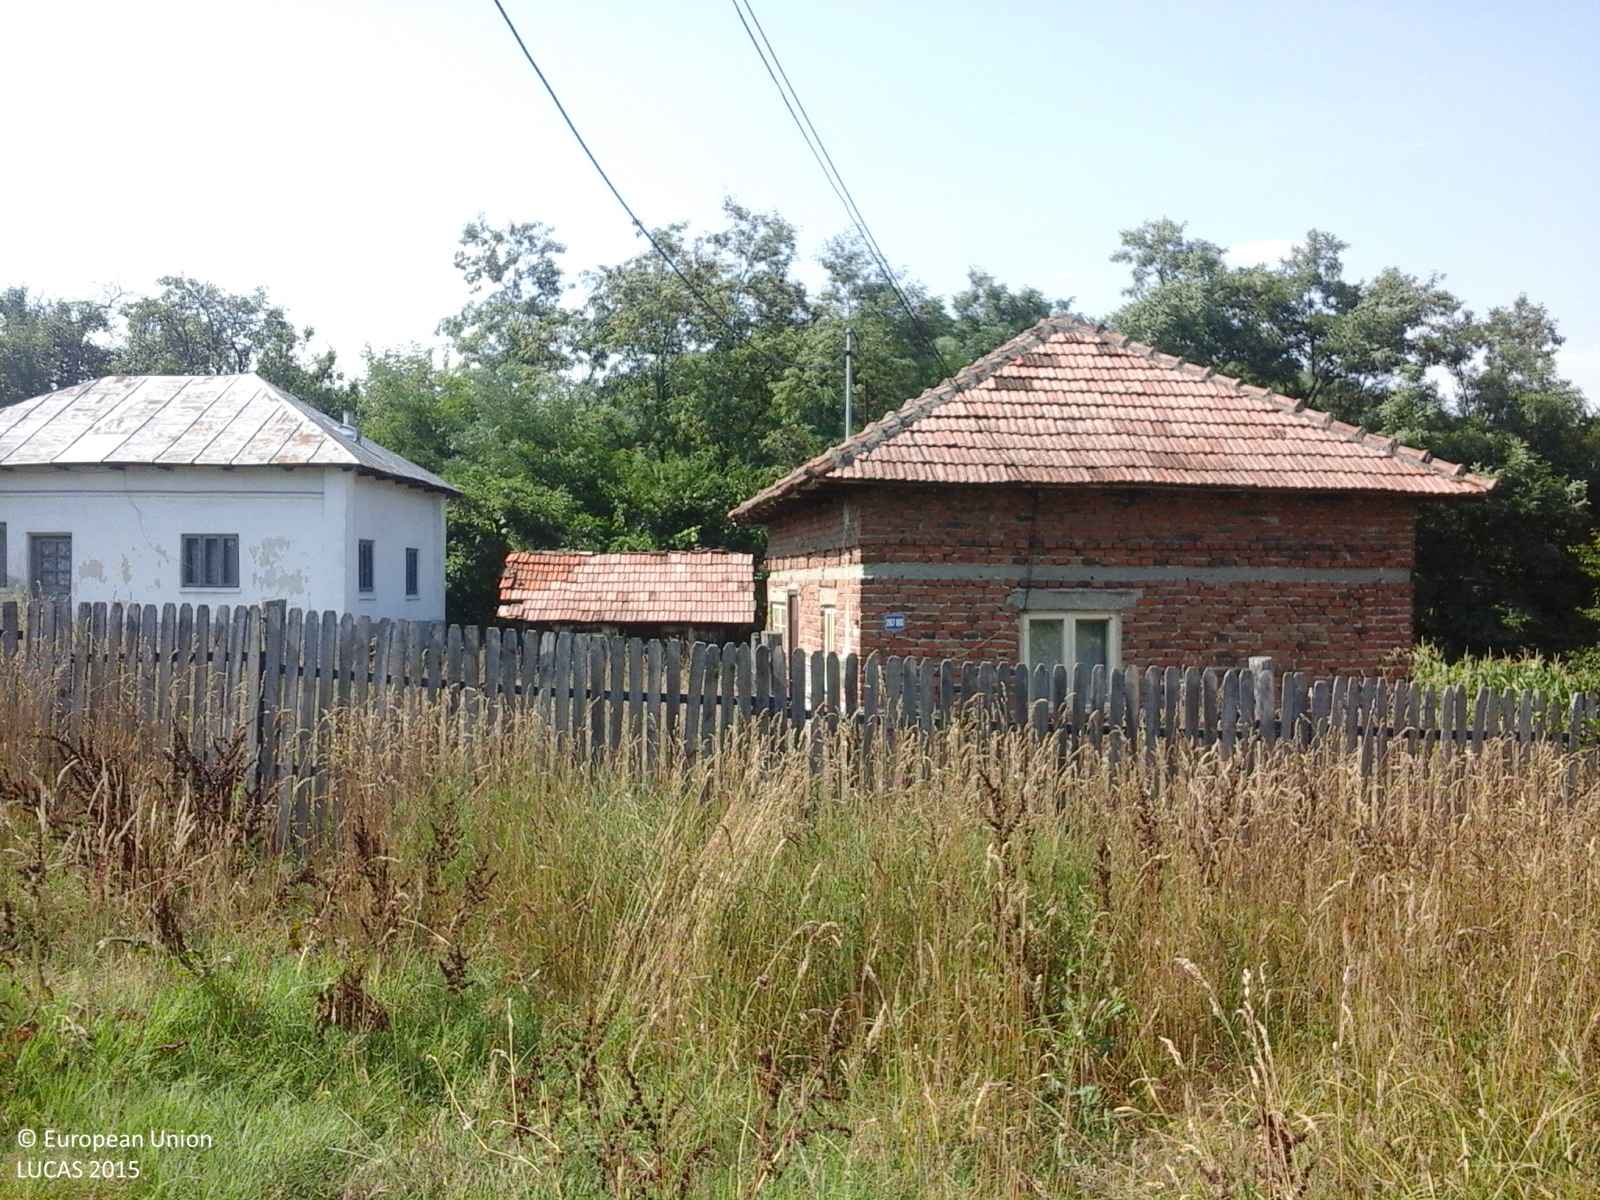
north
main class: Grassland
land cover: Spontaneously vegetated surfaces
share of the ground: > 75 %
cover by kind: herbaceous plants 100 %
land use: Agriculture (excluding fallow land and kitchen gardens)
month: July
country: RO
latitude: 45.0301
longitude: 24.4813
